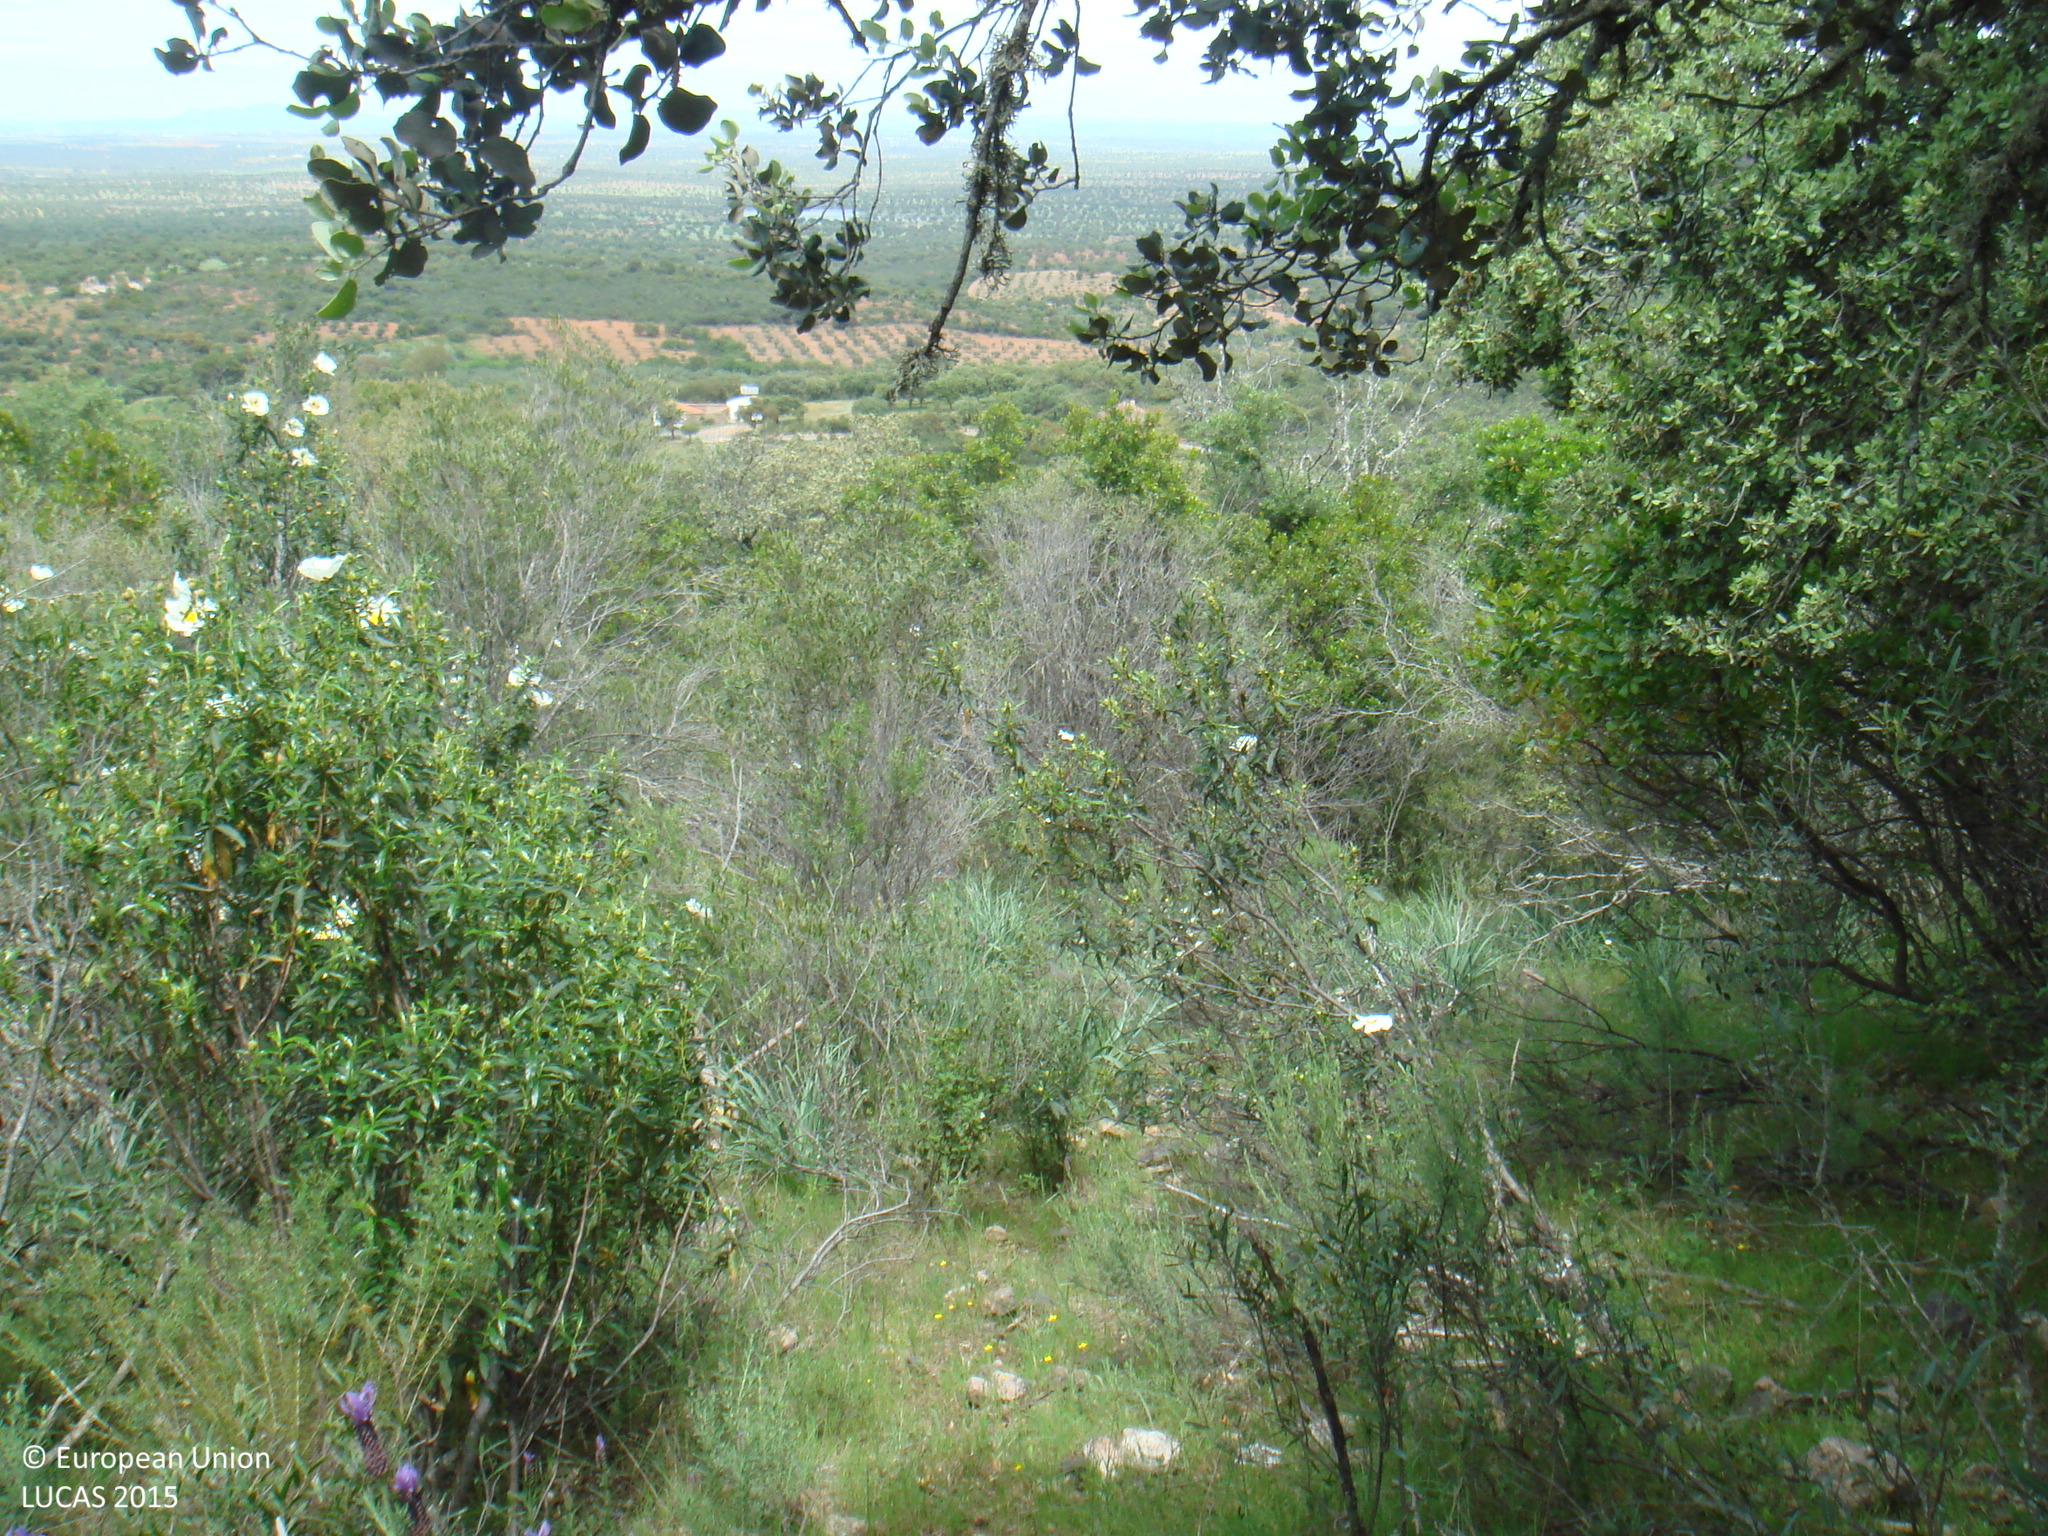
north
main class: Woodland
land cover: Broadleaved woodland
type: broadleaved evergreen forest
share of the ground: 25 - 50 %
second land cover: Shrubland without tree cover
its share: 50 - 75 %
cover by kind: shrubs 50 %, broadleaved forest trees 40 %, herbaceous plants 10 %
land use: Forestry
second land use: Agriculture (excluding fallow land and kitchen gardens)
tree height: > 5 m
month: May
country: ES
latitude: 38.3207
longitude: -5.0899
